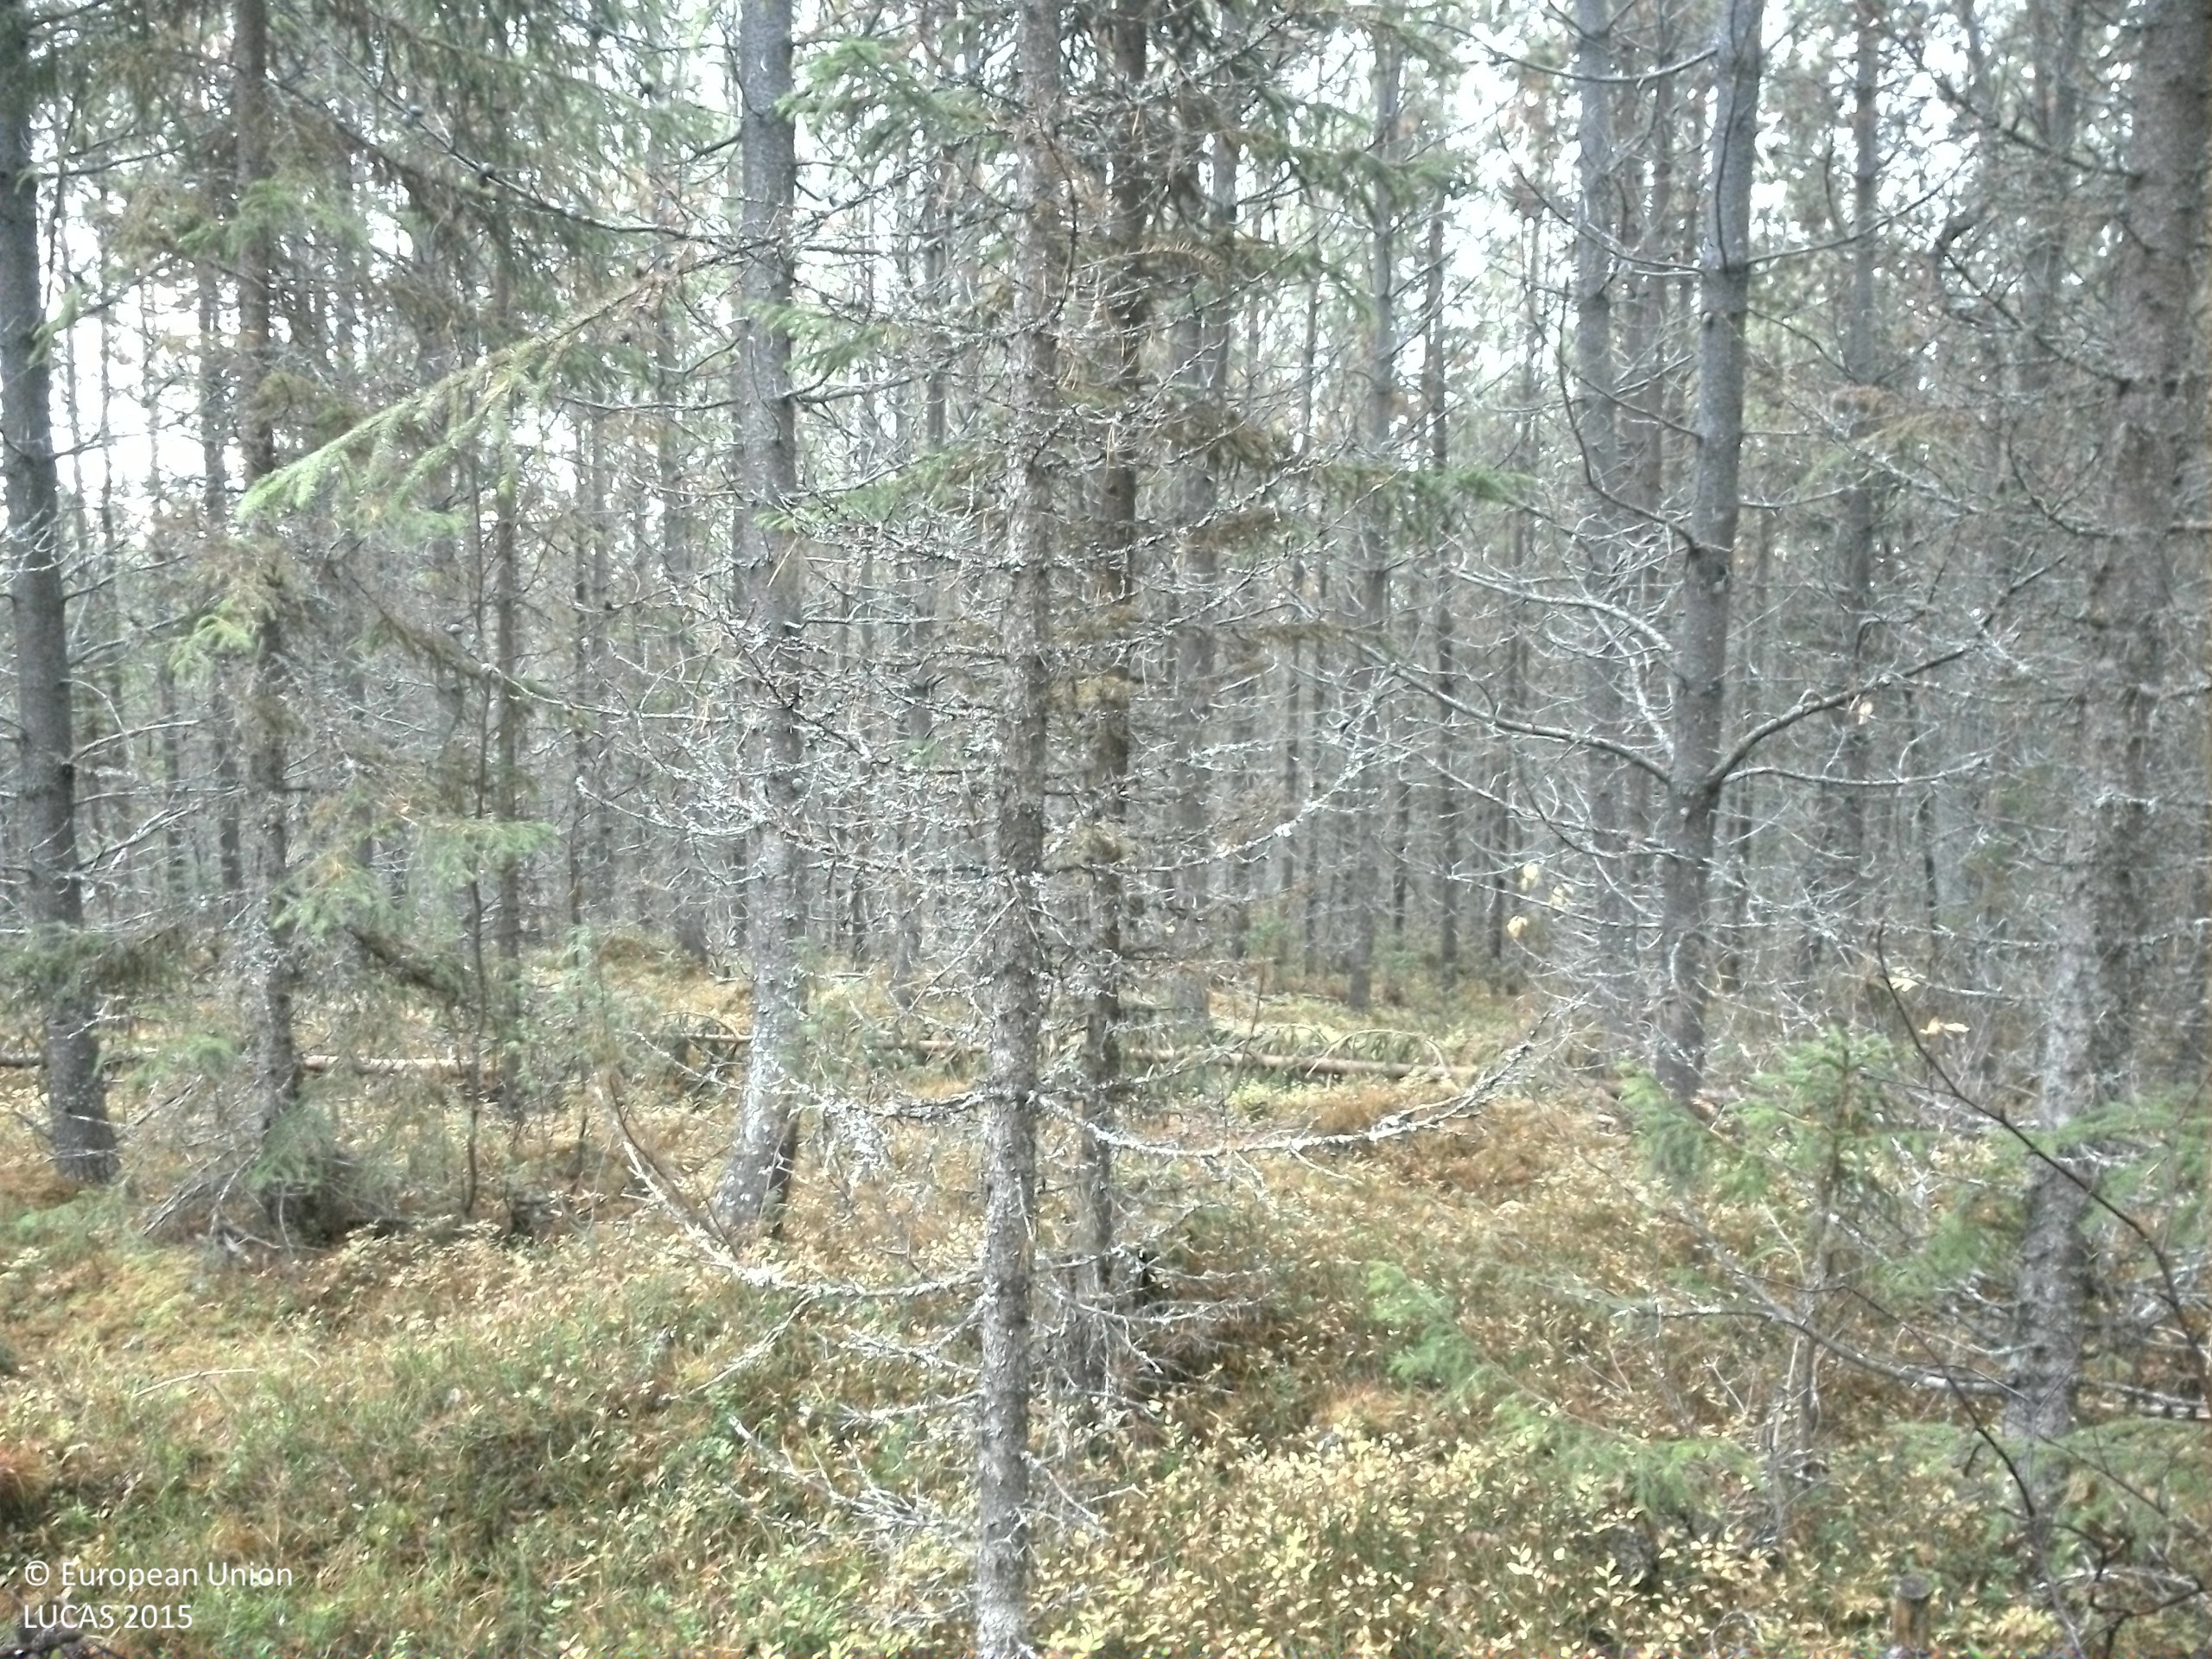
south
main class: Woodland
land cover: Pine dominated coniferous woodland
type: exotic forest
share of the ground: 25 - 50 %
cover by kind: coniferous forest trees 45 %, shrubs 35 %, lichens and mosses 15 %, unconsolidated bare surface 5 %
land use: Forestry
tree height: > 5 m
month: October
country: SE
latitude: 64.3046
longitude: 15.4491
